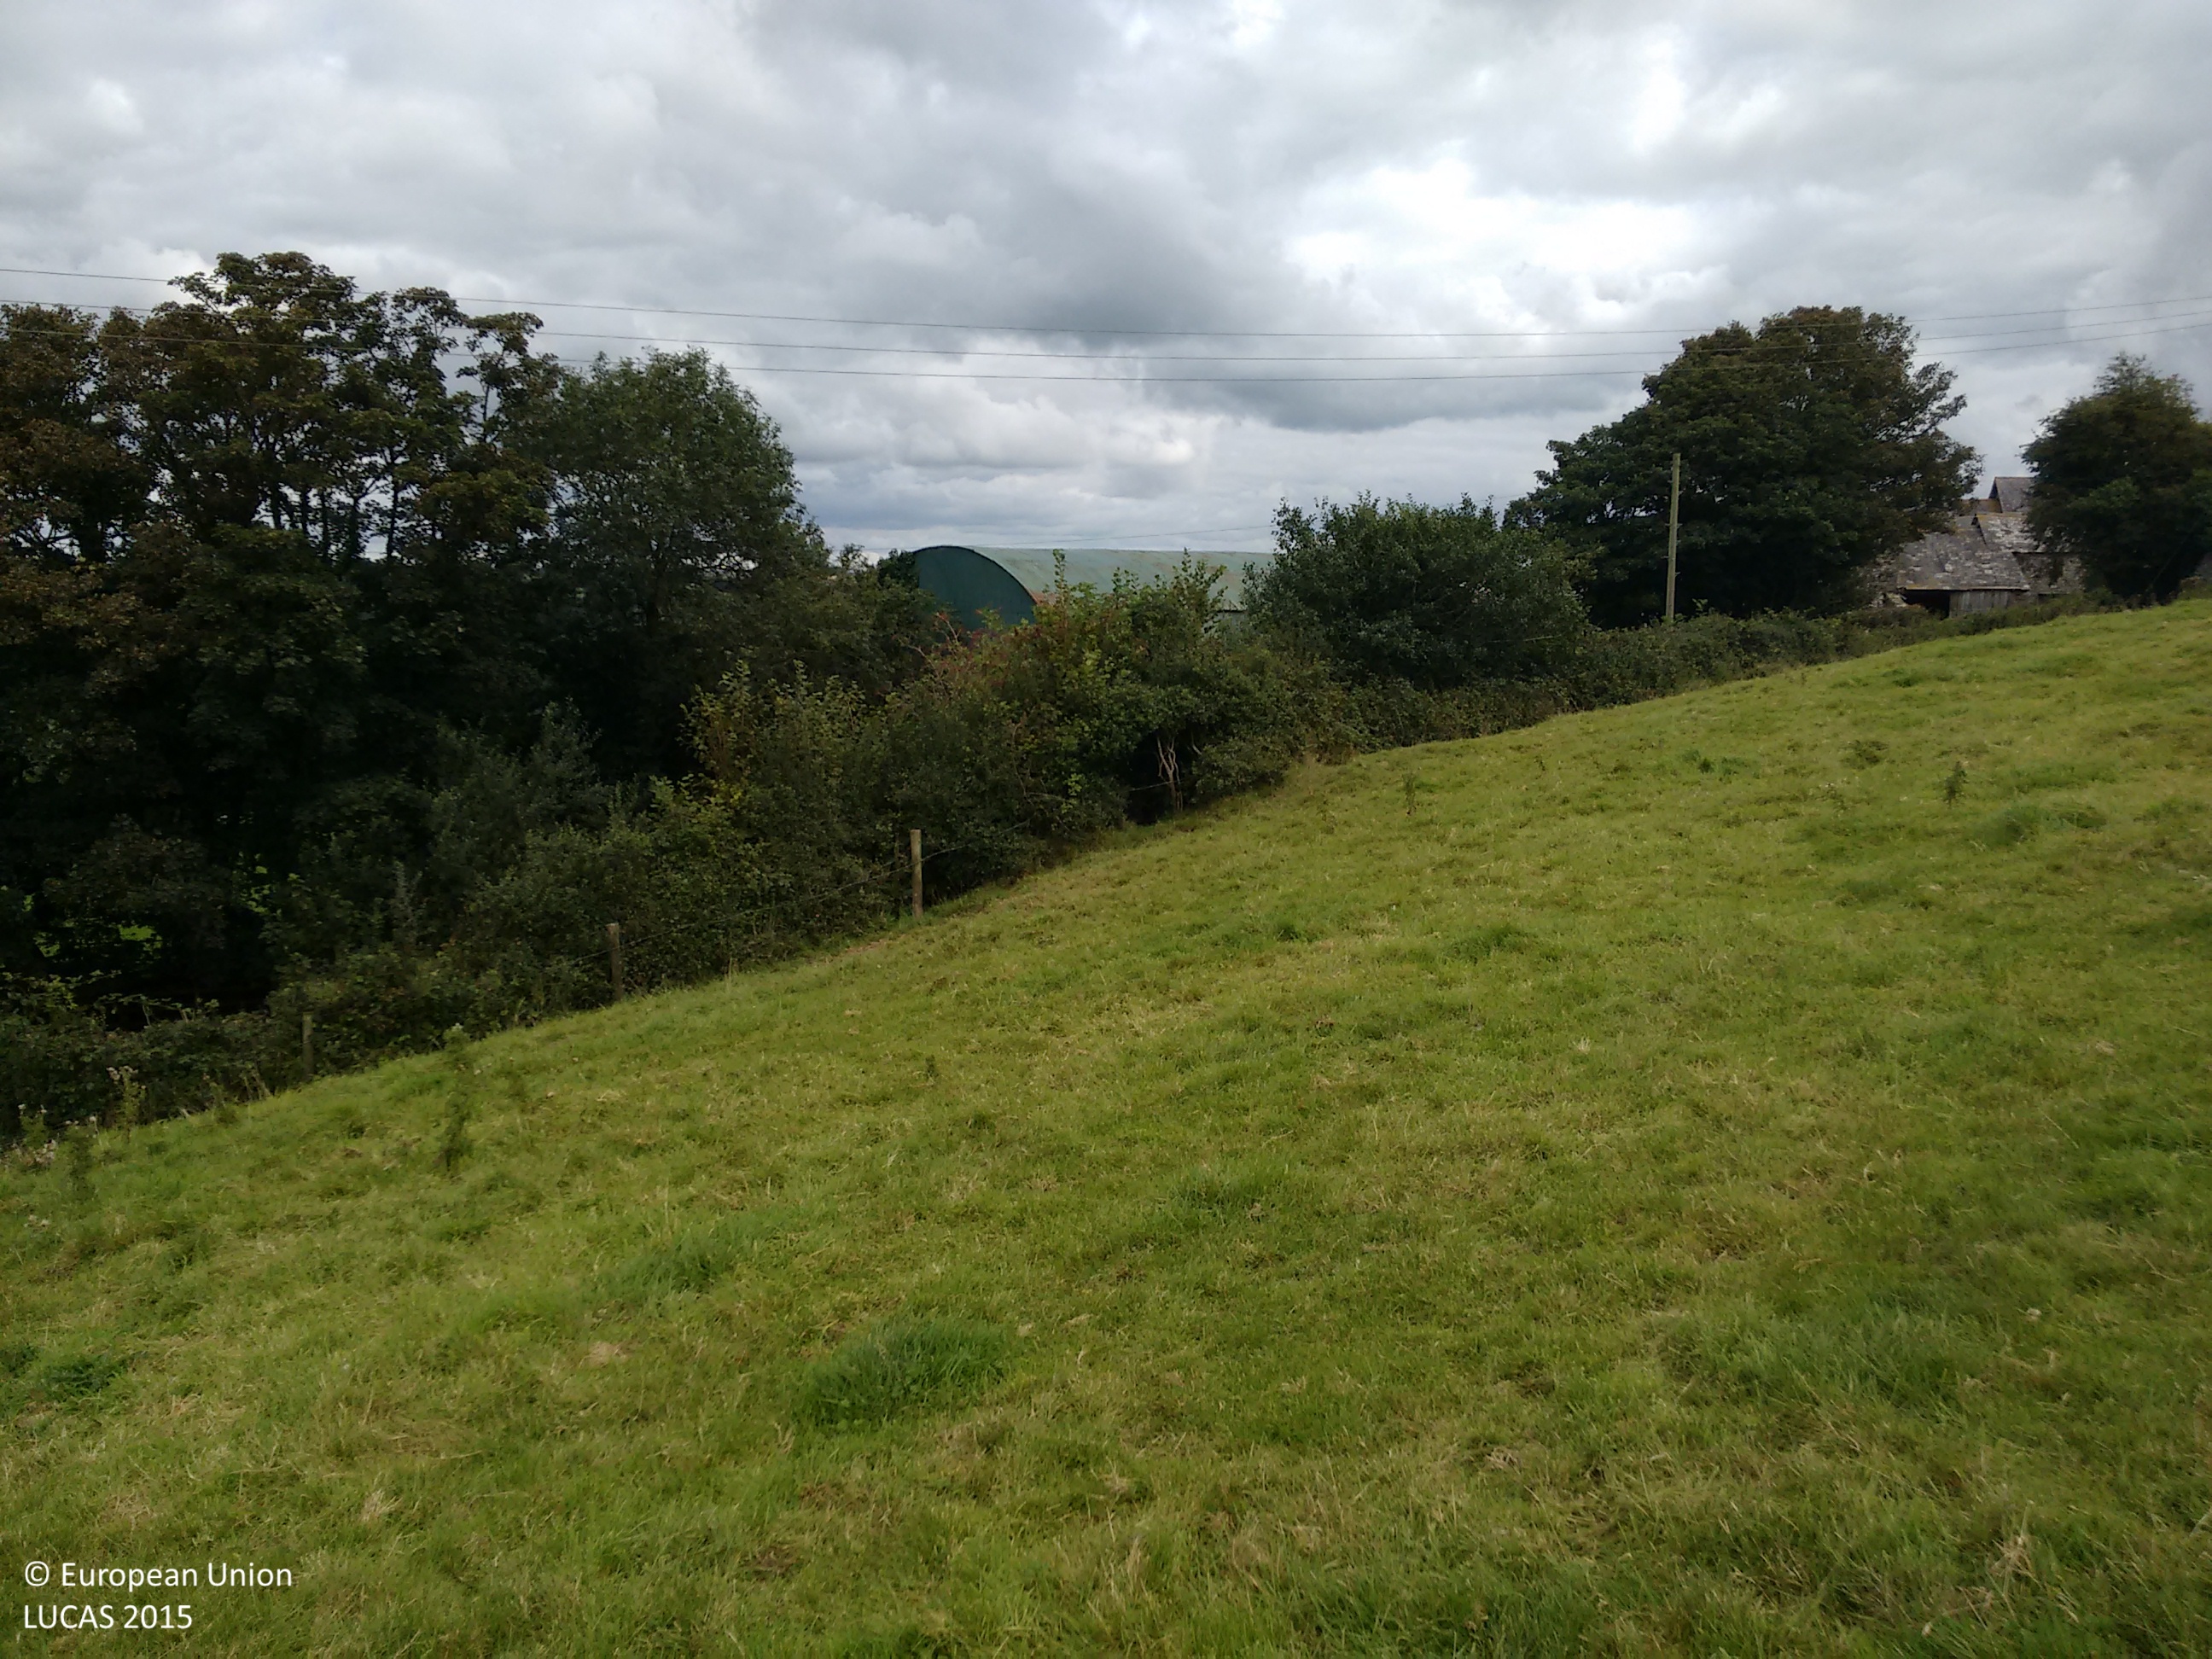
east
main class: Grassland
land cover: Grassland without tree/shrub cover
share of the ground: > 75 %
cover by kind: herbaceous plants 100 %
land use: Agriculture (excluding fallow land and kitchen gardens)
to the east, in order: Grassland without tree/shrub cover; Fences; Managed hedges; Artificial constructions in urban areas; Managed hedges; Dry stone walls; Fences; Grassland without tree/shrub cover; Fences; Managed hedges; Fences; Grassland without tree/shrub cover
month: September
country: GB
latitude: 50.9086
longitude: -4.1047
